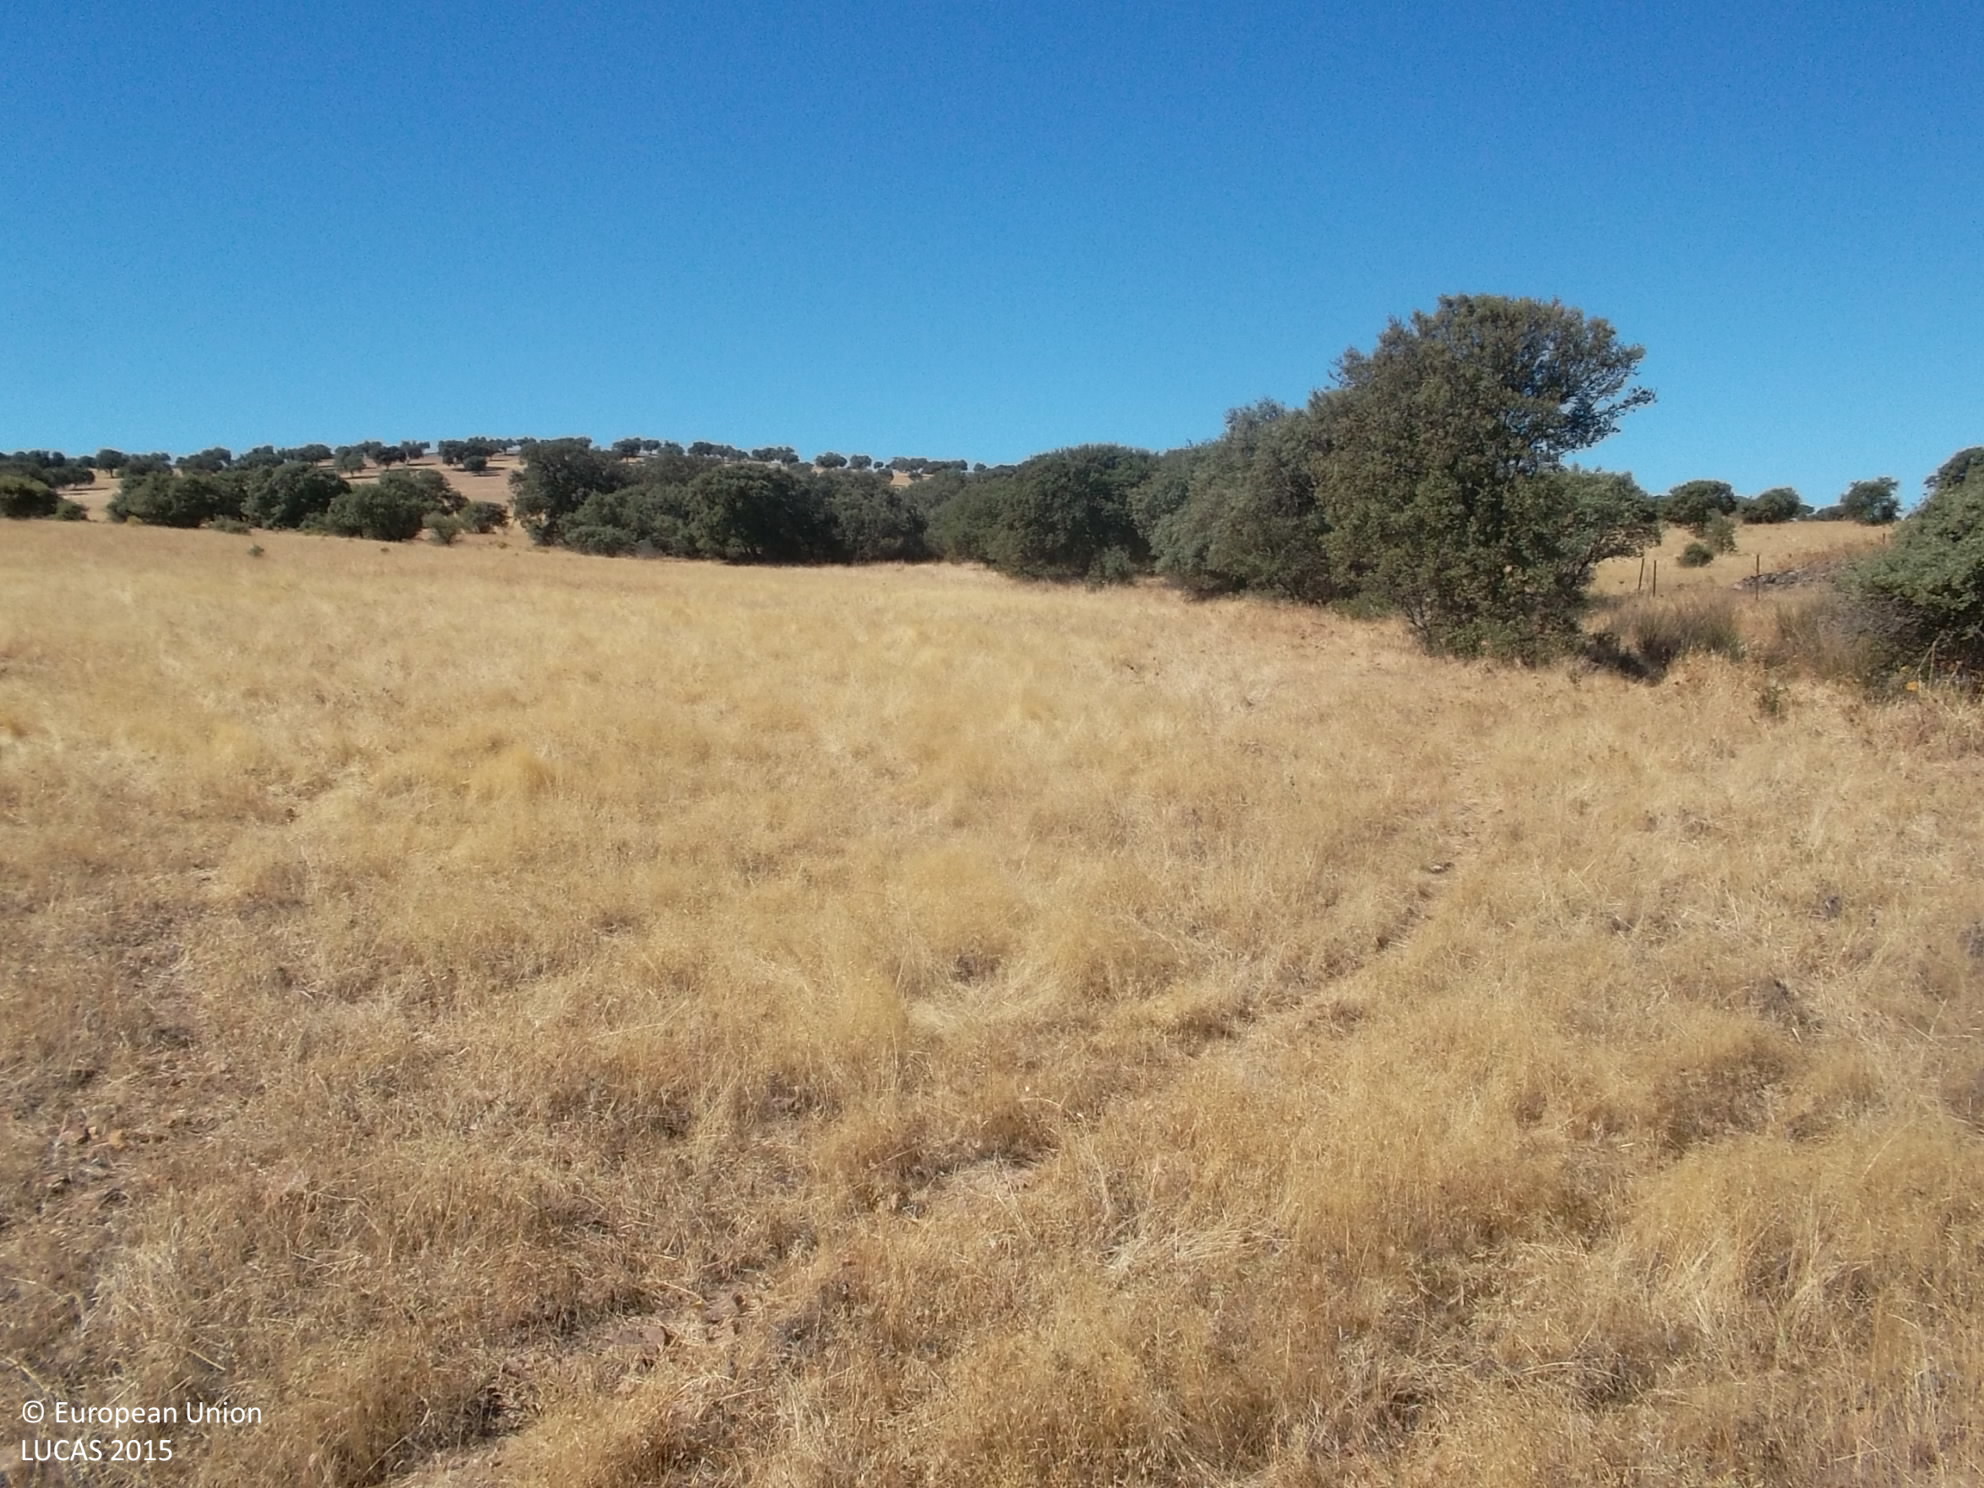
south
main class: Grassland
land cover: Grassland with sparse tree/shrub cover
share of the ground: > 75 %
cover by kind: herbaceous plants 90 %, broadleaved forest trees 5 %, shrubs 5 %
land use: Agriculture (excluding fallow land and kitchen gardens)
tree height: < 5 m
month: July
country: ES
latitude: 38.4555
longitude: -5.8428
